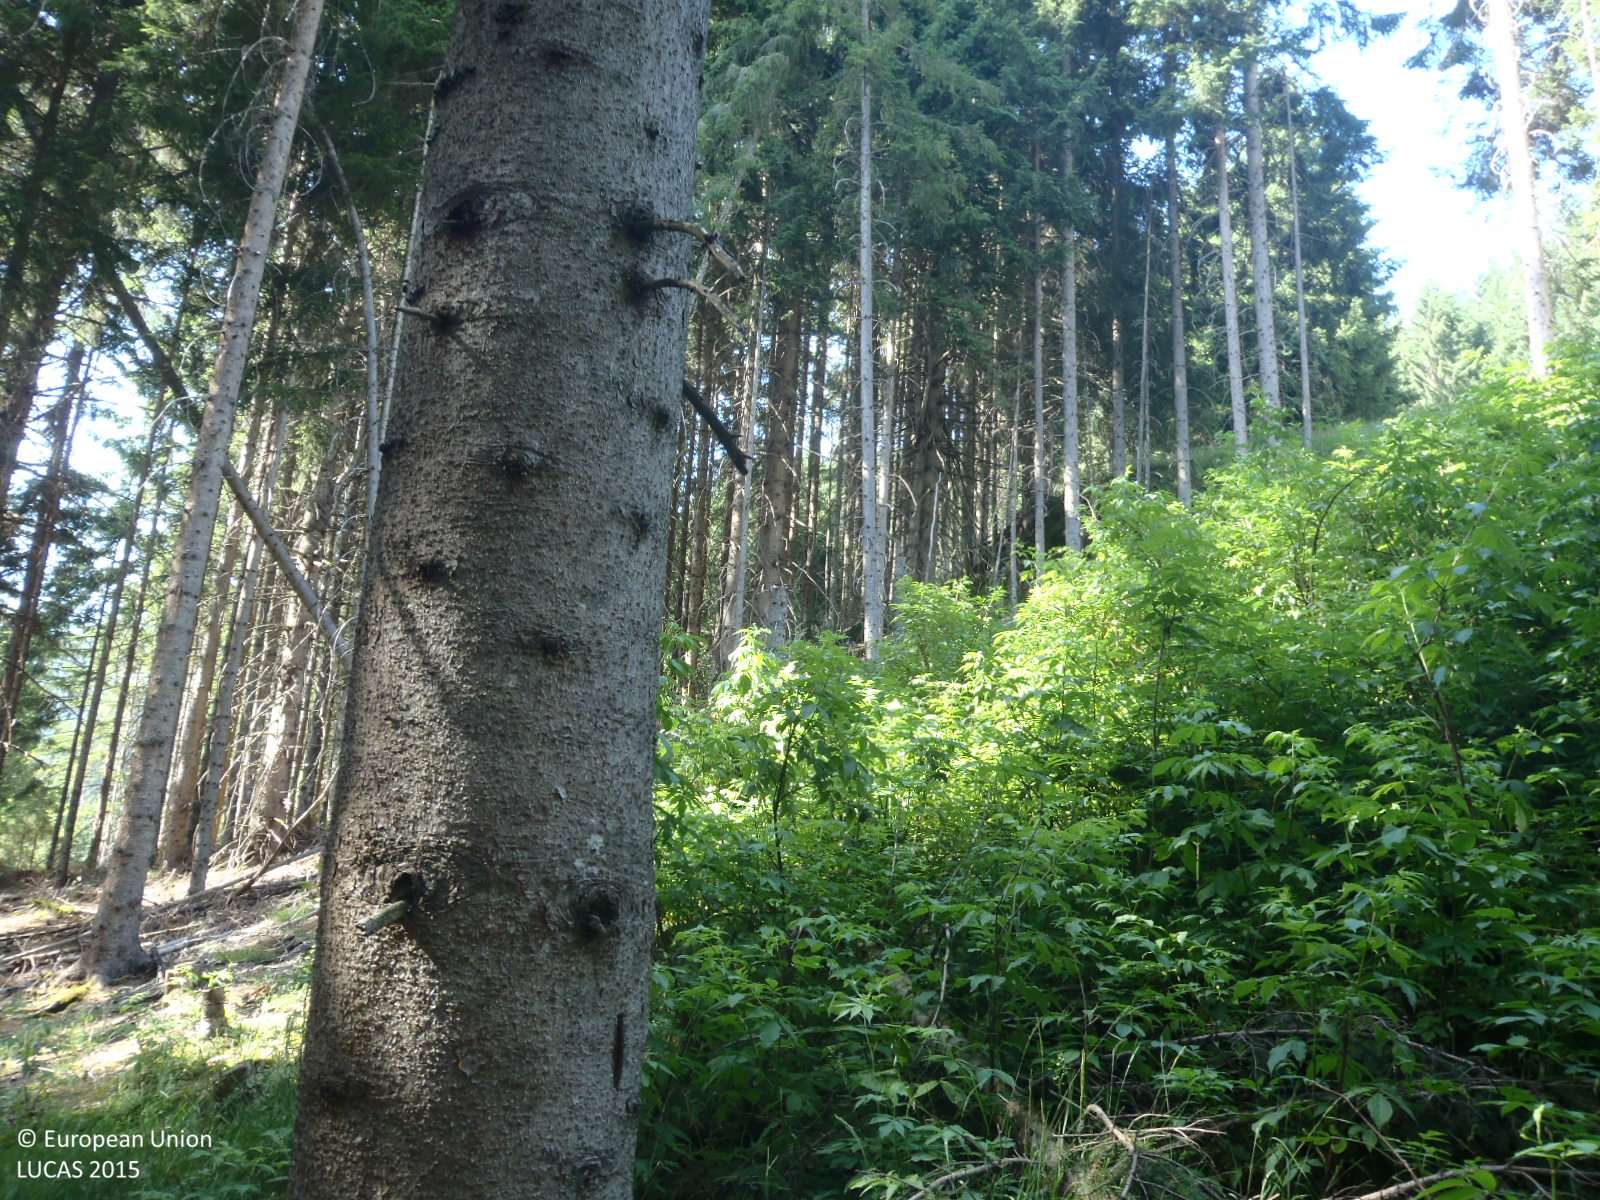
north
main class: Woodland
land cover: Spruce dominated coniferous woodland
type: alpine coniferous forest
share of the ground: > 75 %
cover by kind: coniferous forest trees 100 %
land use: Forestry
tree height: > 5 m
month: July
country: AT
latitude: 47.0895
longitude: 10.0132
